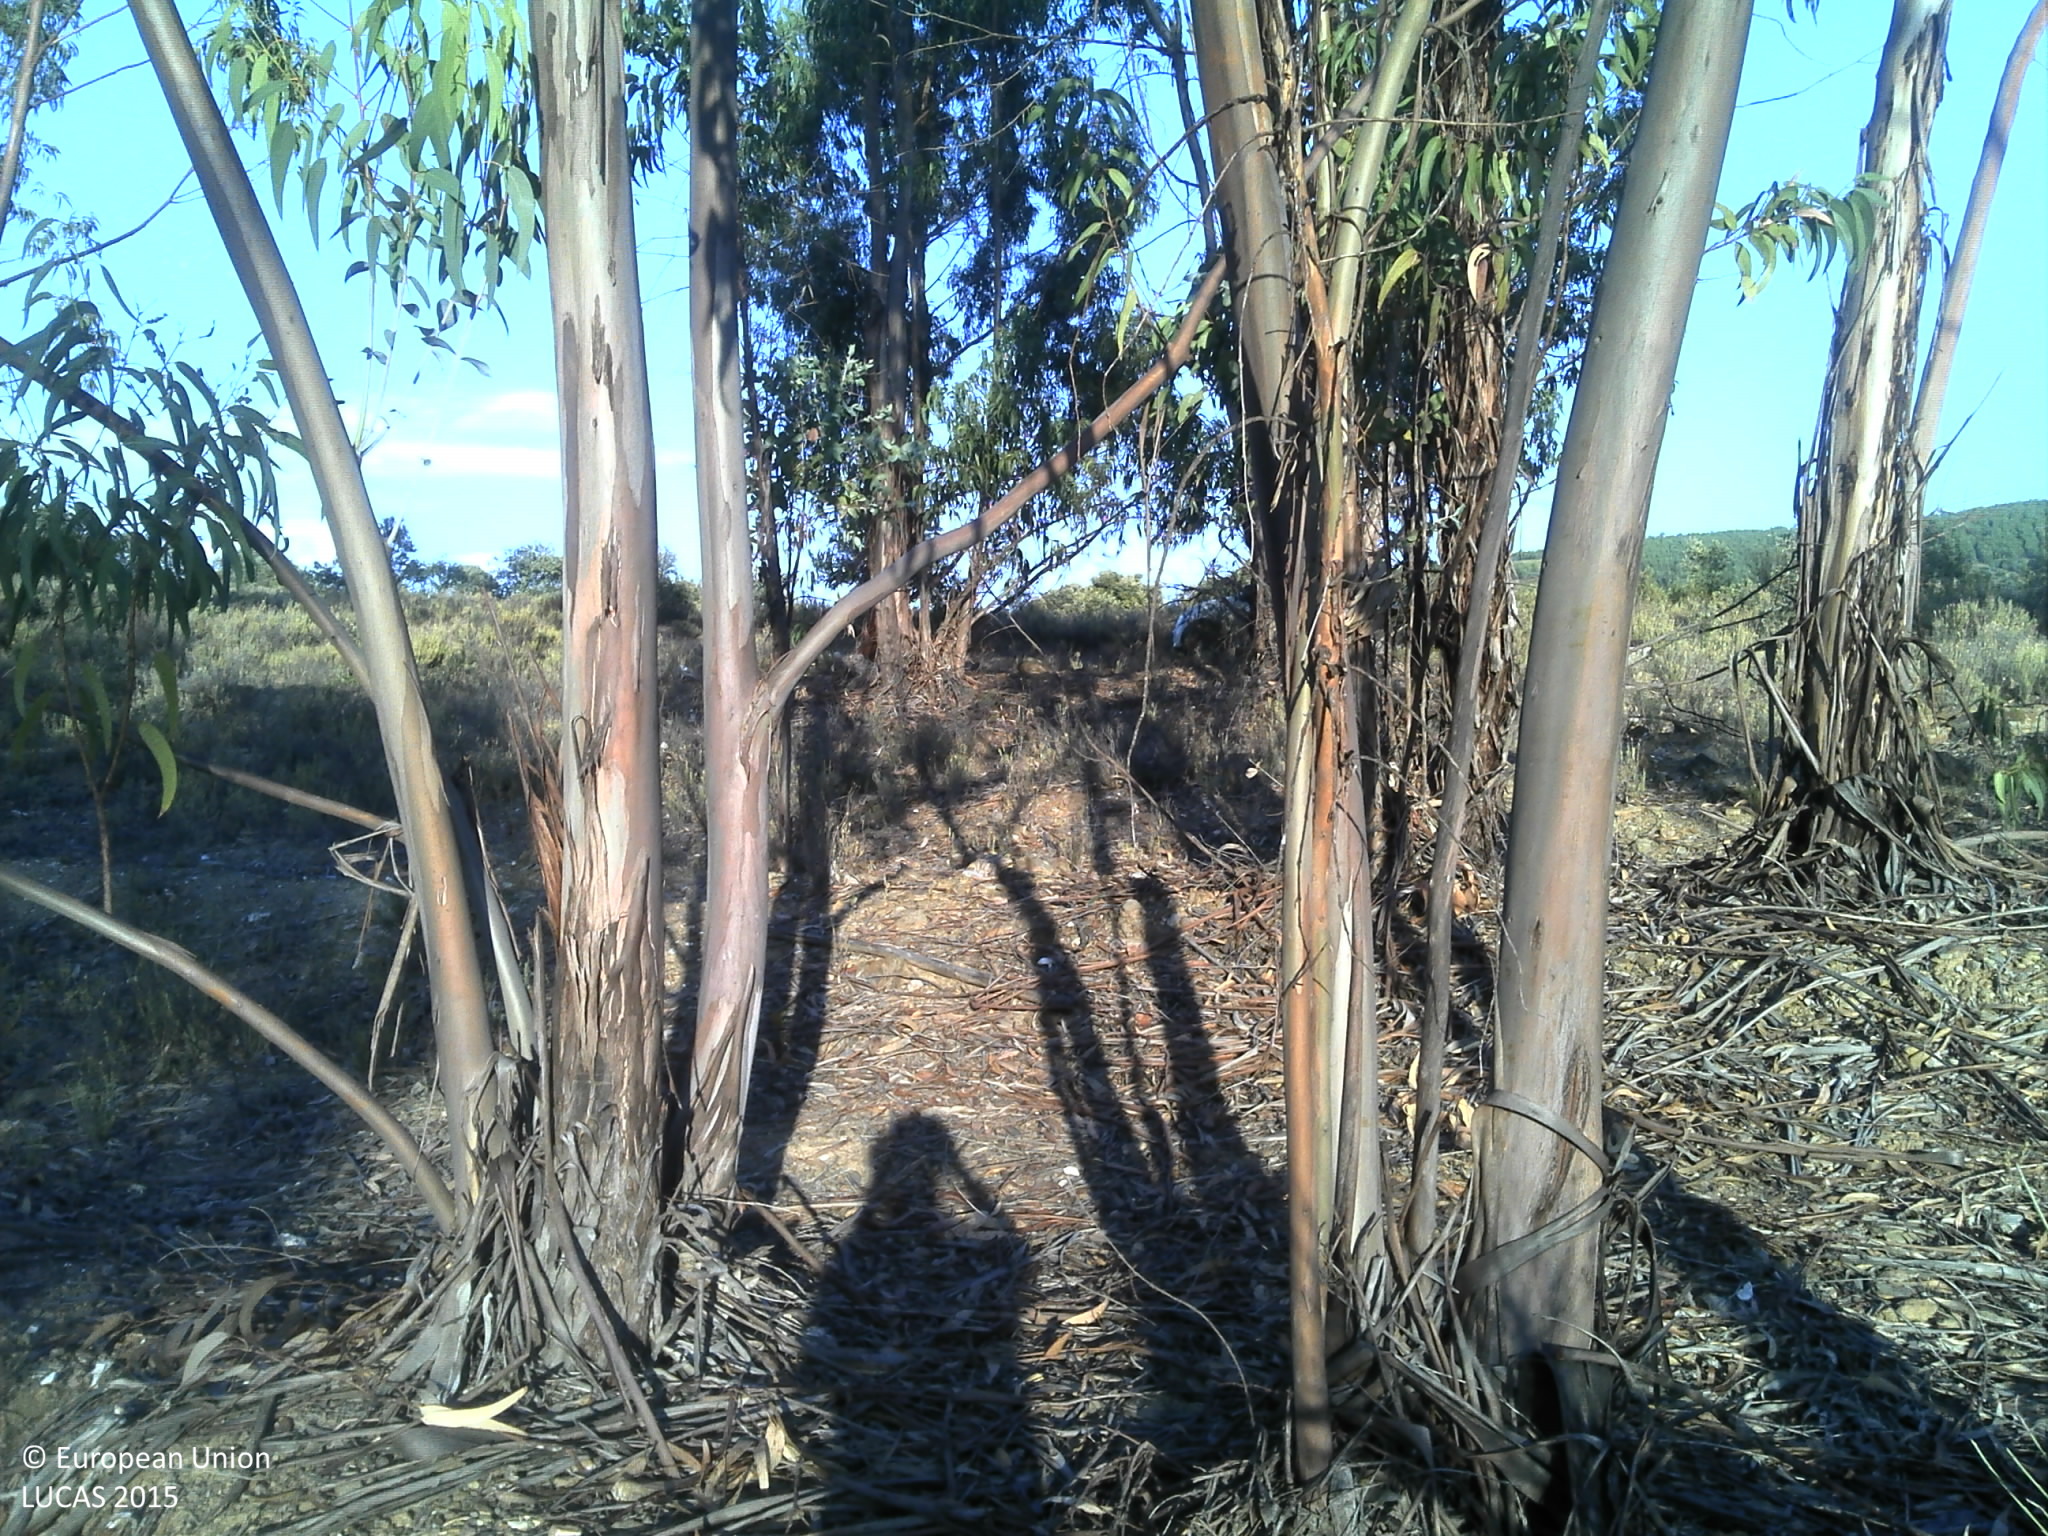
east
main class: Woodland
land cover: Broadleaved woodland
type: exotic forest
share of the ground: 25 - 50 %
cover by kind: unconsolidated bare surface 50 %, broadleaved forest trees 35 %, shrubs 5 %, herbaceous plants 5 %
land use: Forestry
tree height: > 5 m
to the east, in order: Broadleaved woodland; Tracks; Shrubland with sparse tree cover; Tracks; Fences; Grassland with sparse tree/shrub cover; Fences; Tracks; Broadleaved woodland; Spontaneously vegetated surfaces
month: June
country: PT
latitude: 39.9902
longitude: -6.9899
